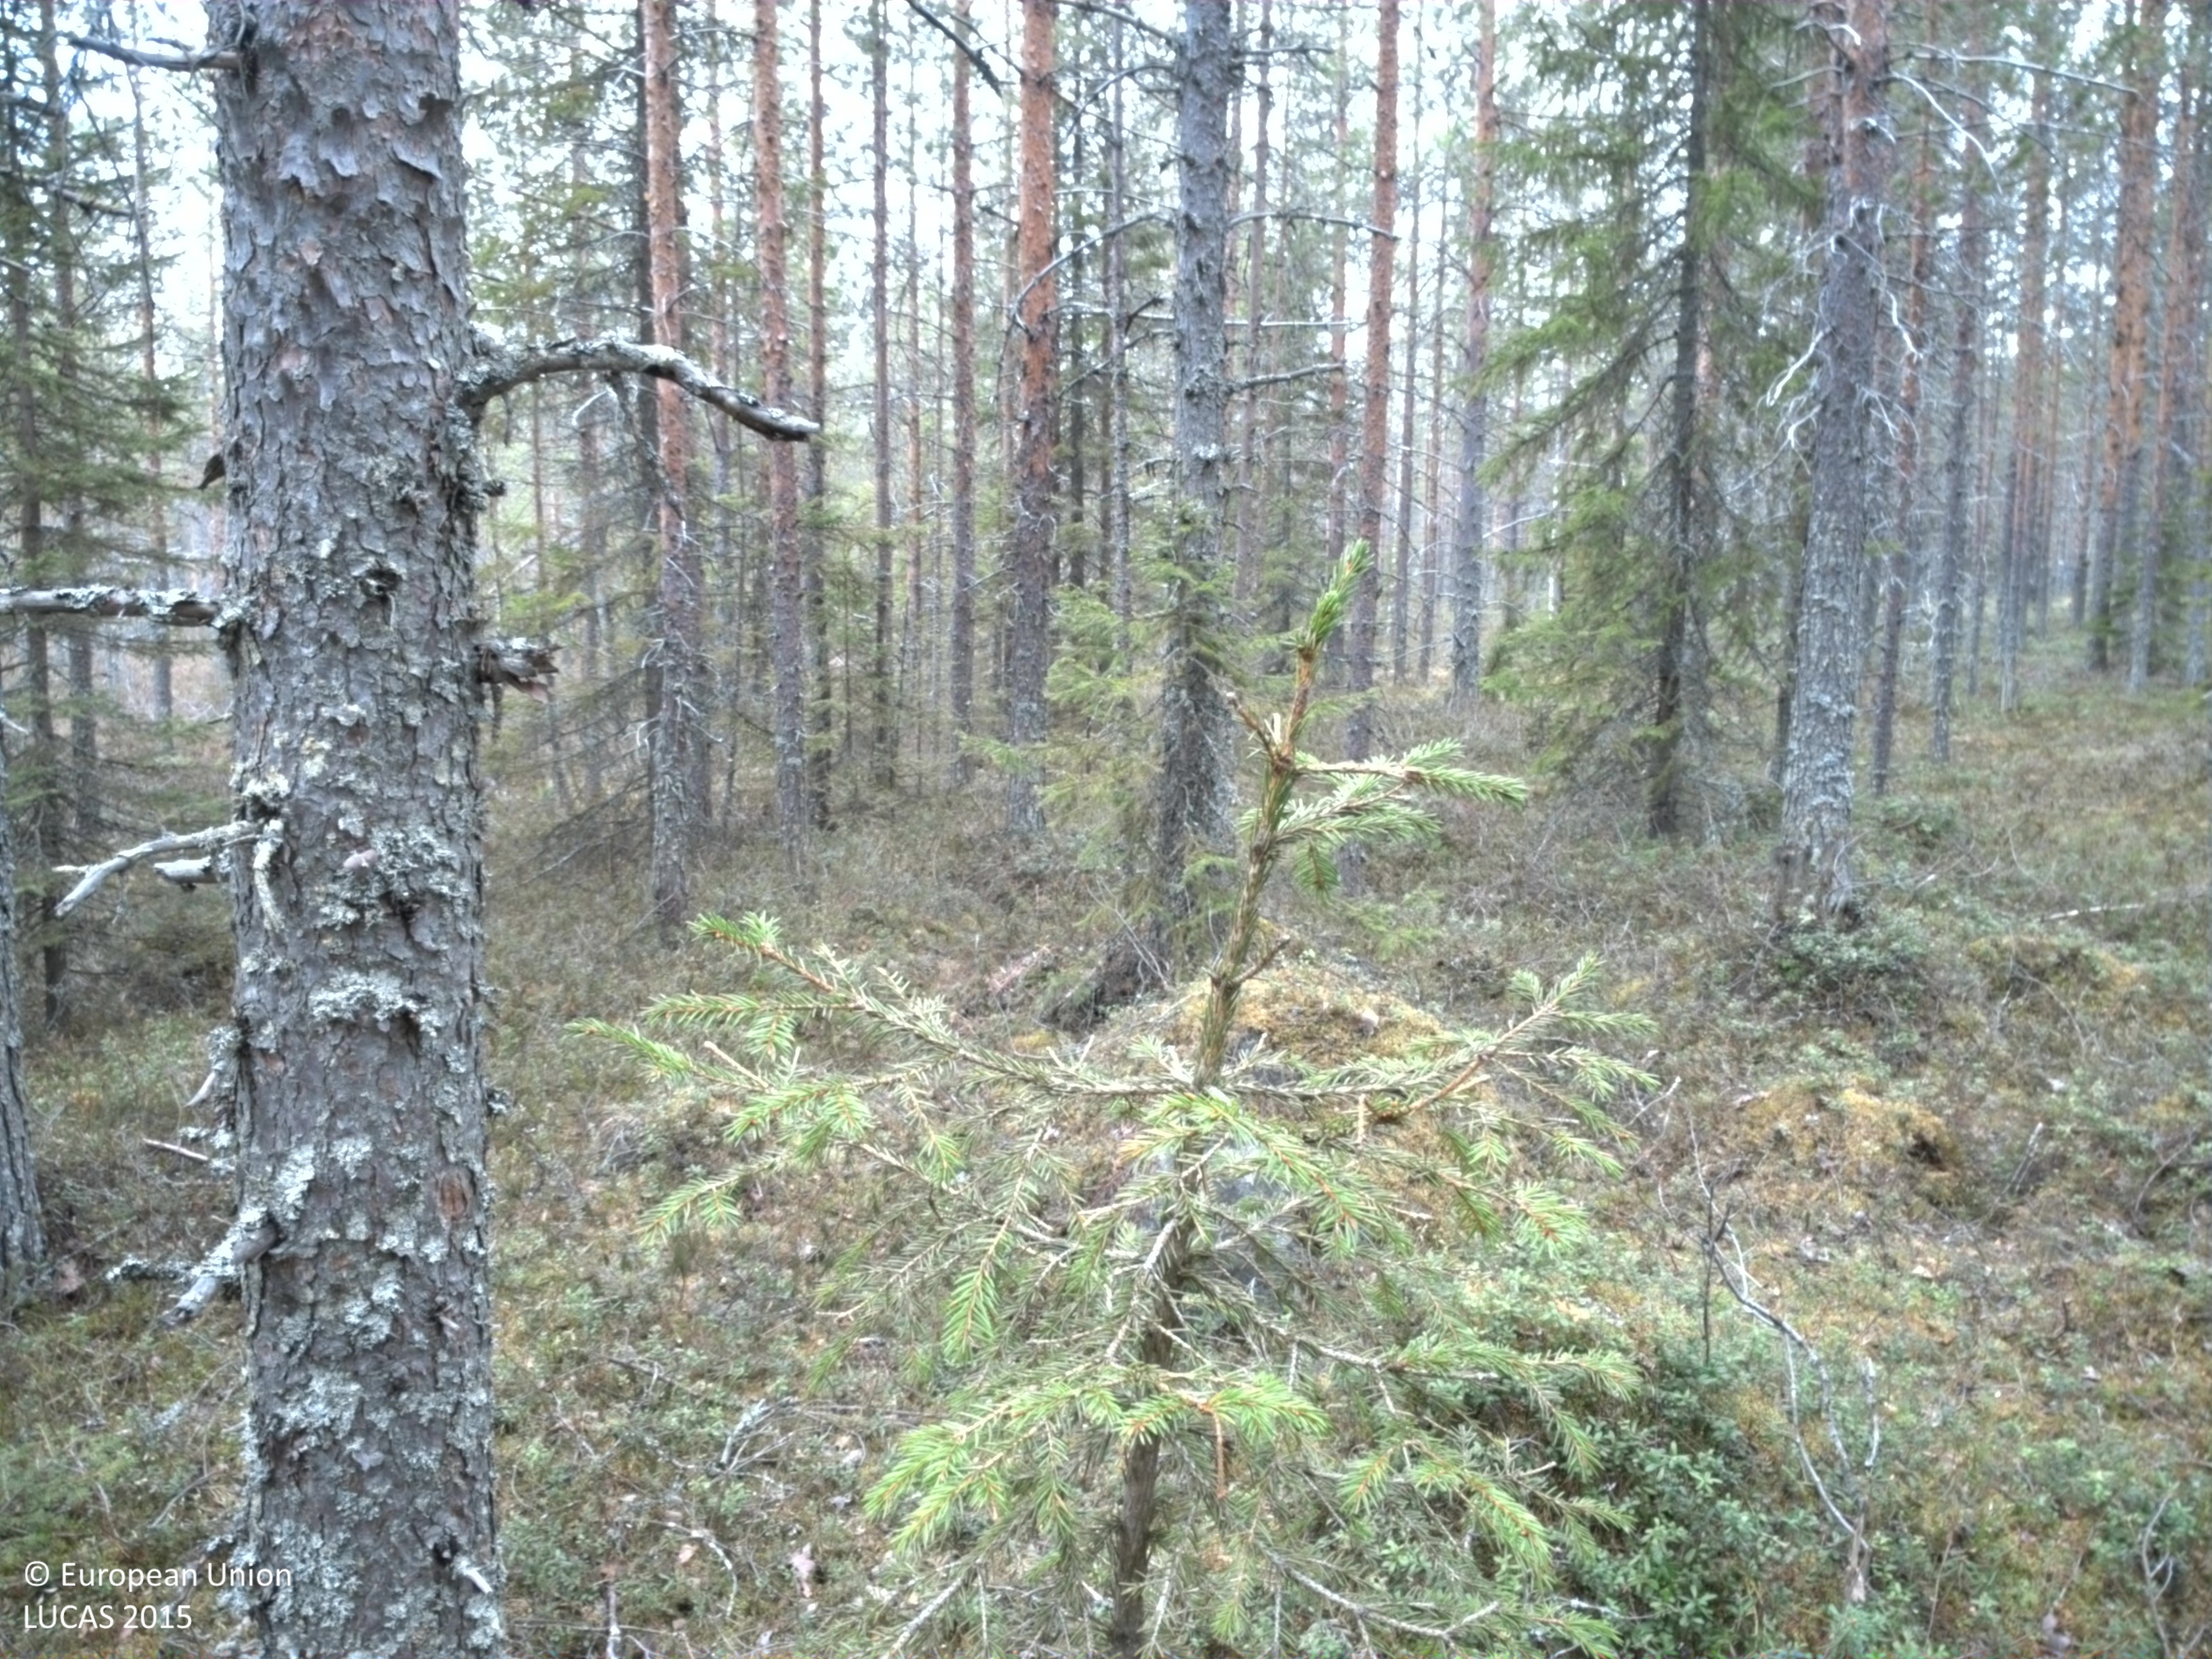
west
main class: Woodland
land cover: Pine dominated coniferous woodland
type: boreal forest
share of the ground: 50 - 75 %
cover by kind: coniferous forest trees 60 %, shrubs 35 %, lichens and mosses 5 %
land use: Forestry
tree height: > 5 m
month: May
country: SE
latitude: 66.0034
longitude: 23.3203
